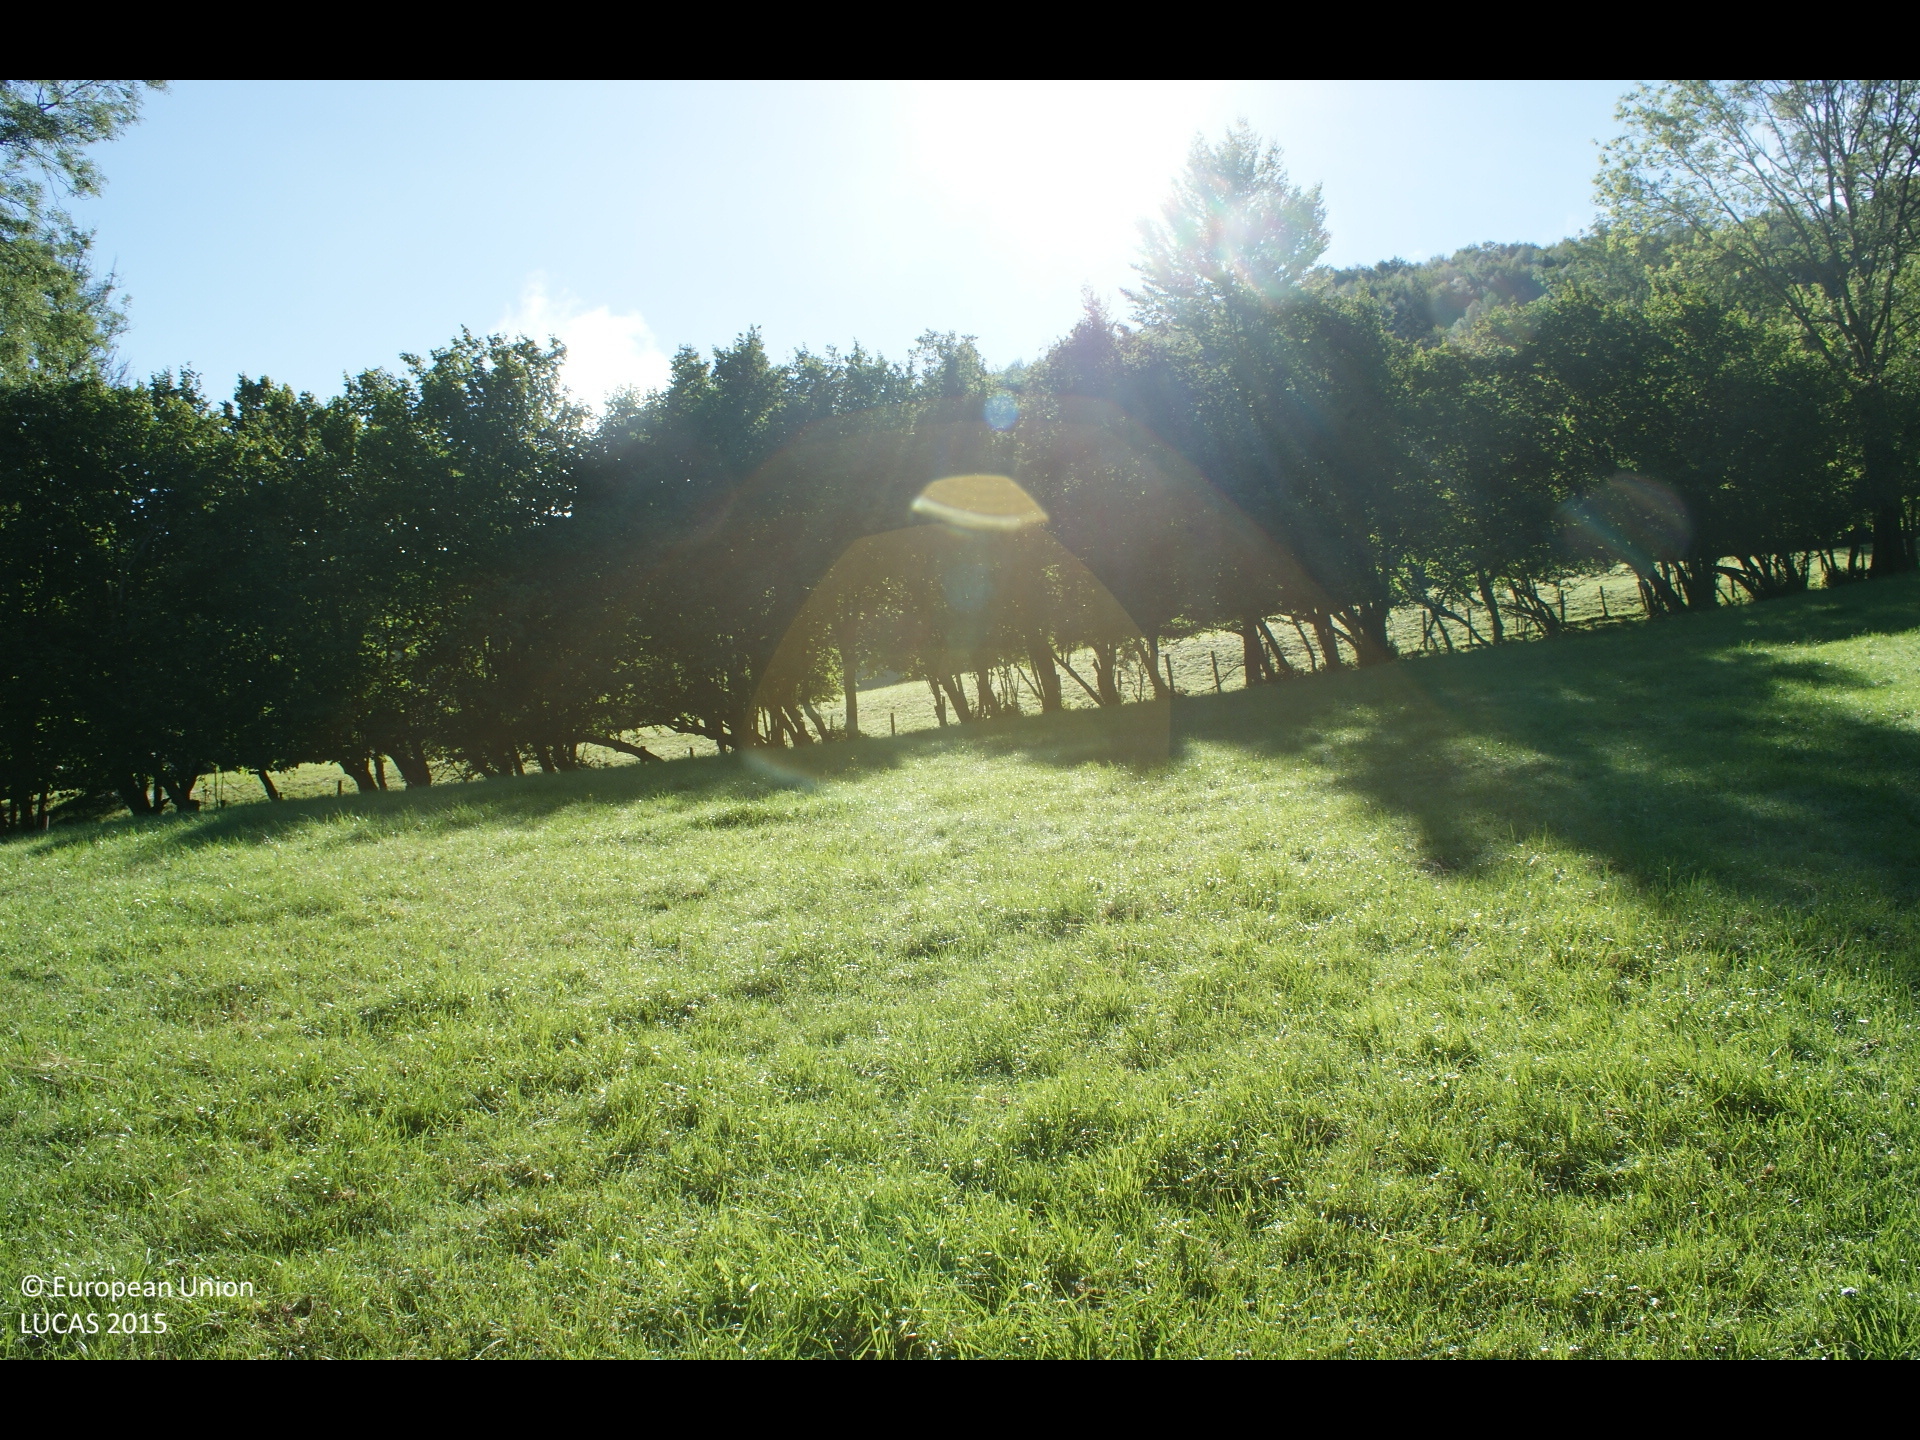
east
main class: Grassland
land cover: Grassland without tree/shrub cover
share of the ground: > 75 %
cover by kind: herbaceous plants 100 %
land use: Agriculture (excluding fallow land and kitchen gardens)
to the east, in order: Grassland without tree/shrub cover; Broadleaved woodland; Fences; Grassland without tree/shrub cover; Spruce dominated mixed woodland; Fences; Spruce dominated mixed woodland
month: August
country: AT
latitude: 47.9205
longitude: 14.8045
